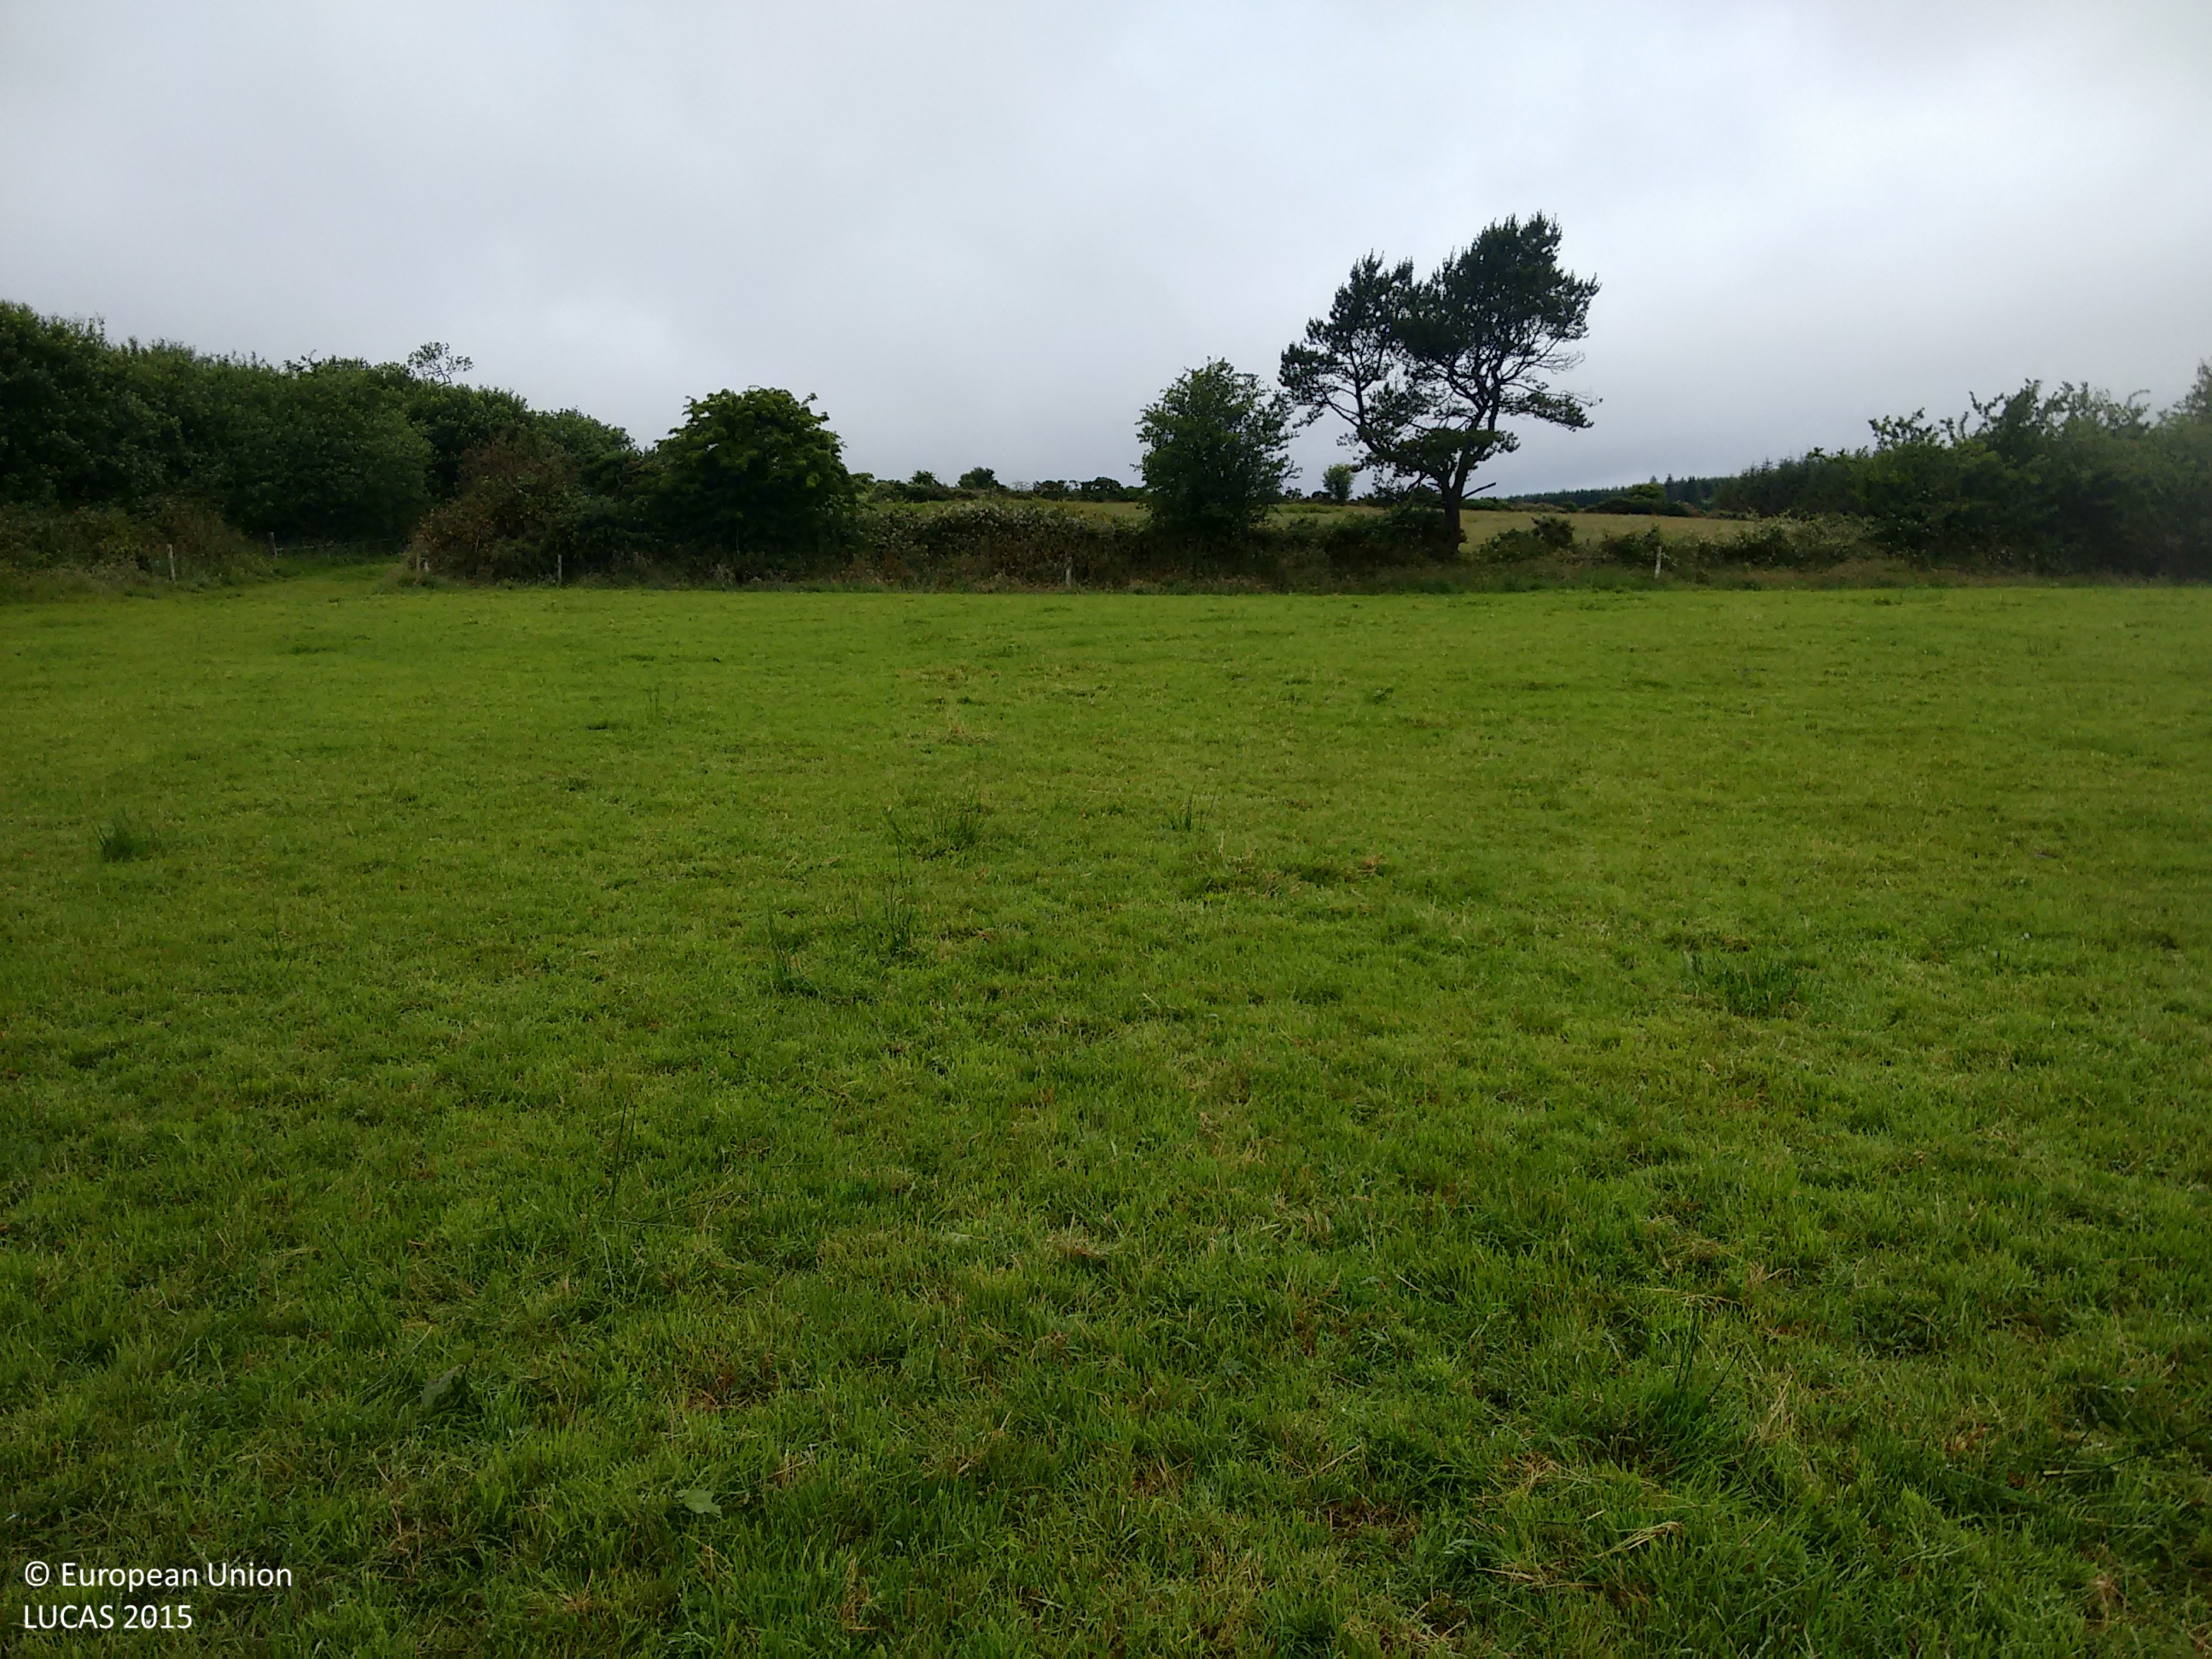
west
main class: Grassland
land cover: Grassland without tree/shrub cover
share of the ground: > 75 %
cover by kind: herbaceous plants 100 %
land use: Agriculture (excluding fallow land and kitchen gardens)
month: July
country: IE
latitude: 52.0859
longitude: -8.3885
